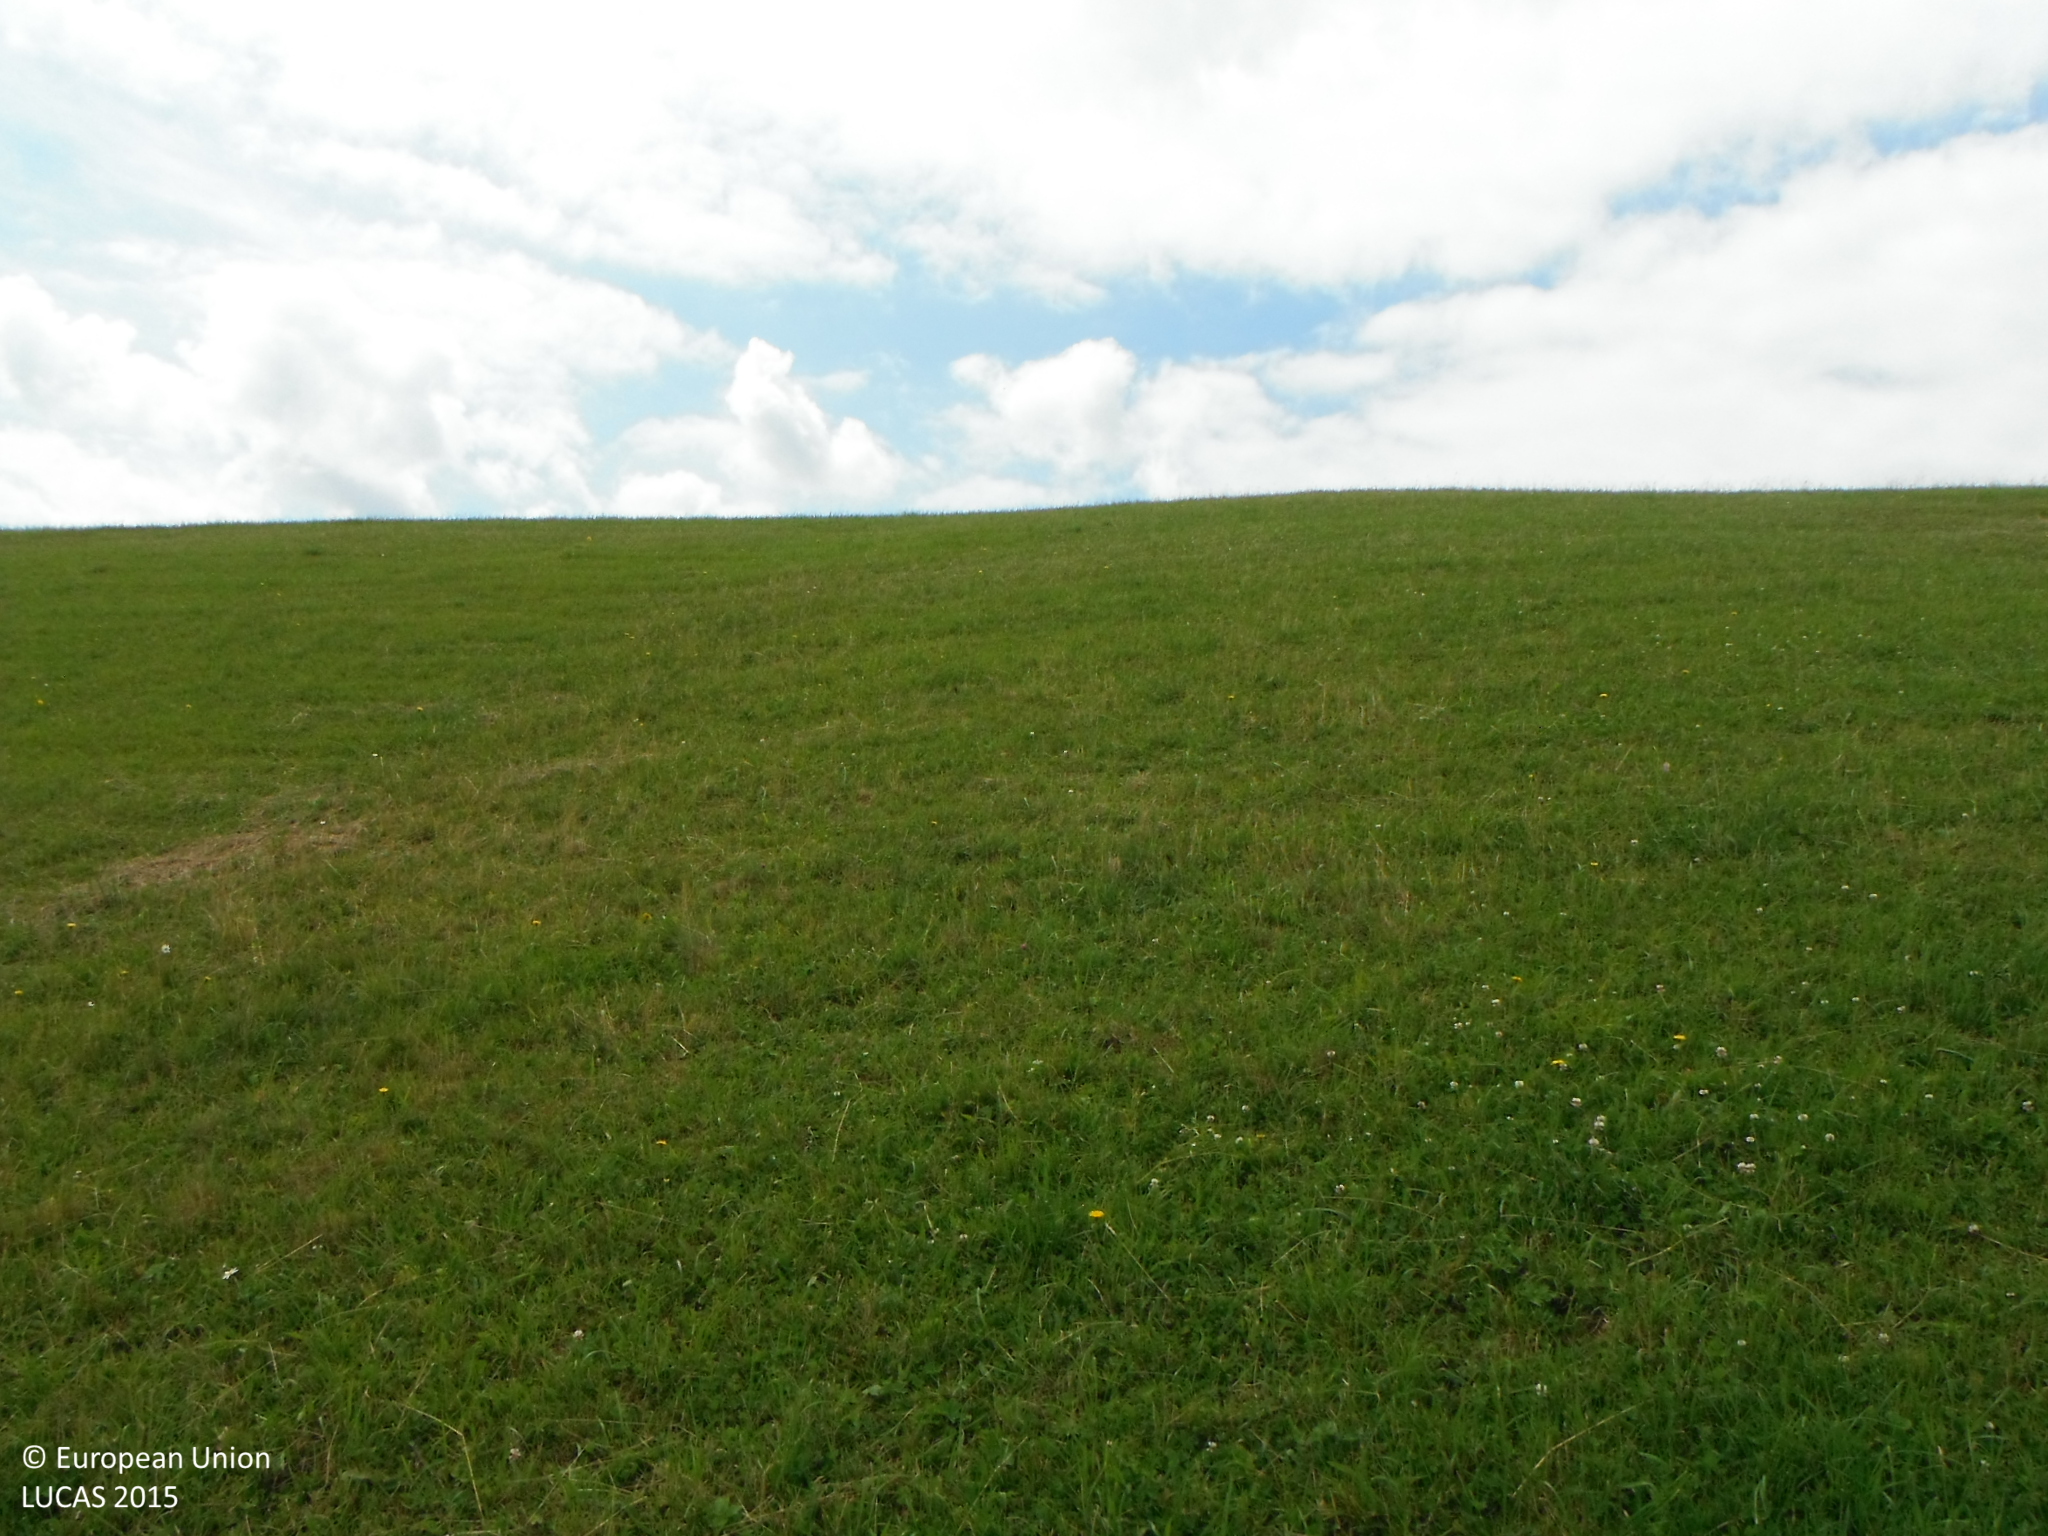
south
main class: Grassland
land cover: Grassland without tree/shrub cover
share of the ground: > 75 %
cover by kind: herbaceous plants 100 %
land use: Agriculture (excluding fallow land and kitchen gardens)
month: June
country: SK
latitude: 49.2114
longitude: 19.2349
